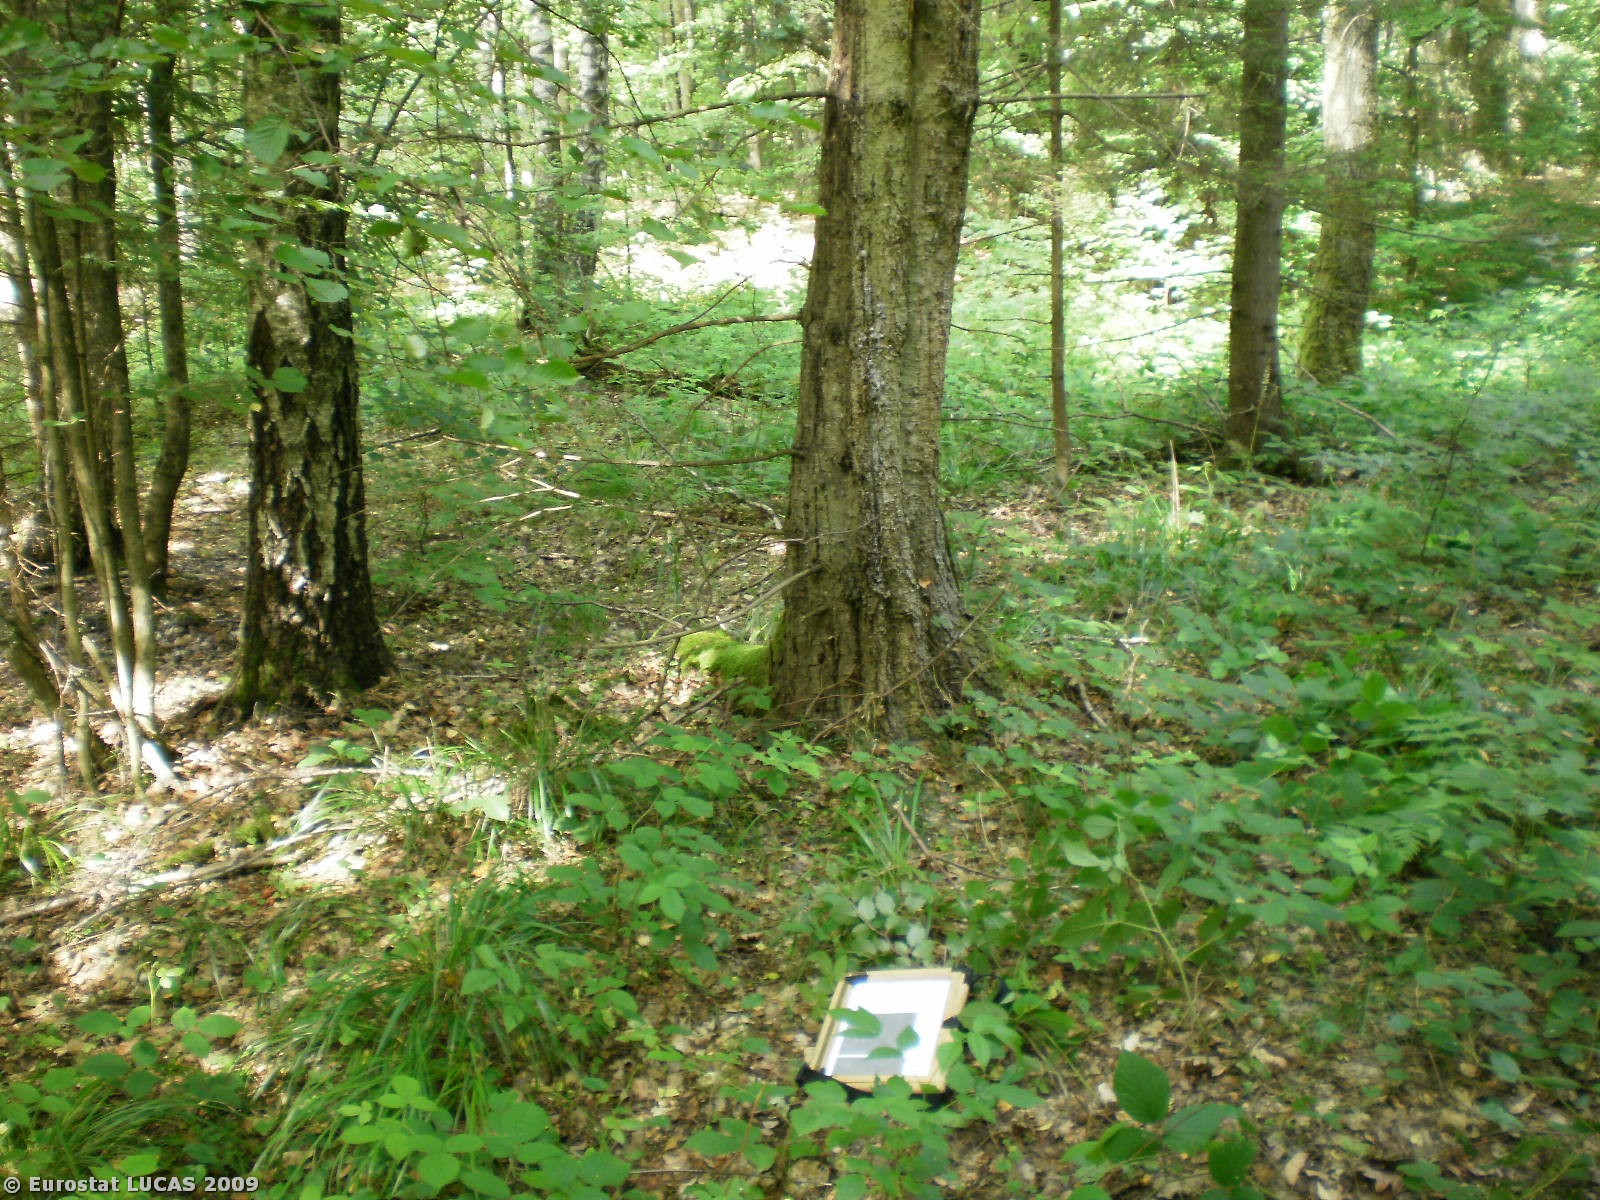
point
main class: Woodland
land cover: Mixed woodland
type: hemiboreal forest and nemoral coniferous forest and mixed broadleaved-coniferous forest
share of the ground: > 75 %
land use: Forestry
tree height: > 5 m
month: July
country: PL
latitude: 53.8828
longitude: 19.9034
